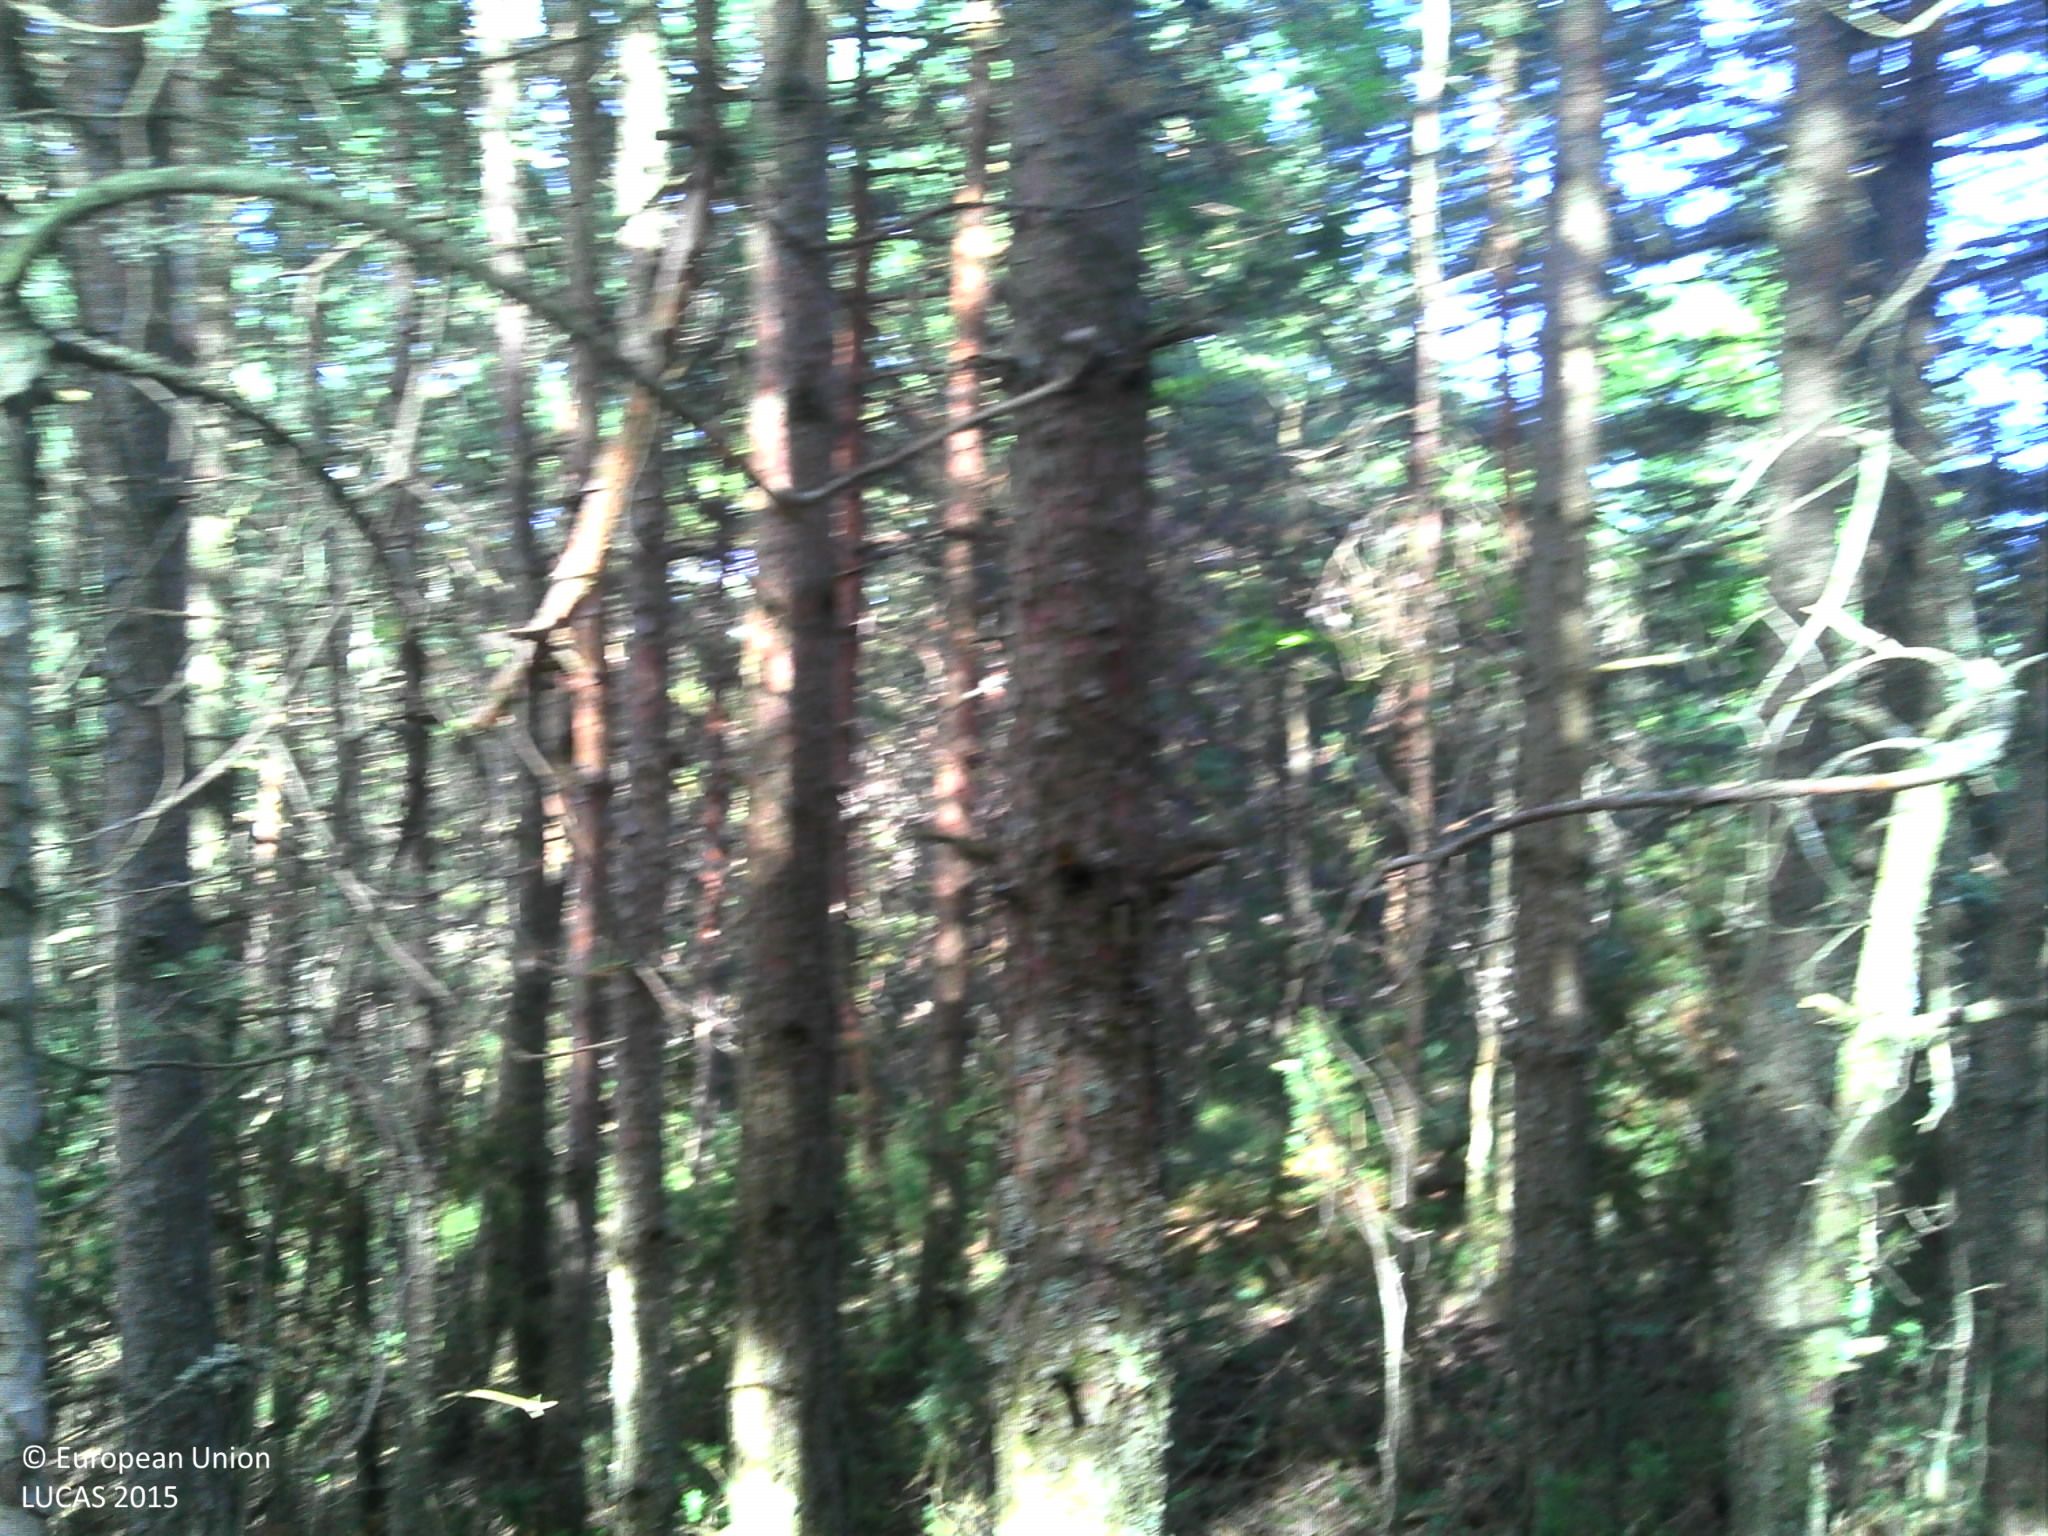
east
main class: Woodland
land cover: Pine dominated coniferous woodland
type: hemiboreal forest and nemoral coniferous forest and mixed broadleaved-coniferous forest
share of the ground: > 75 %
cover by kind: coniferous forest trees 95 %, broadleaved forest trees 5 %
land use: Forestry
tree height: > 5 m
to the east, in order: Pine dominated coniferous woodland; Tracks; Pine dominated coniferous woodland; Tracks; Pine dominated coniferous woodland; Fences; Grassland without tree/shrub cover; Fences; Temporary grasslands
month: July
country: FR
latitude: 44.5253
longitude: 3.1974
